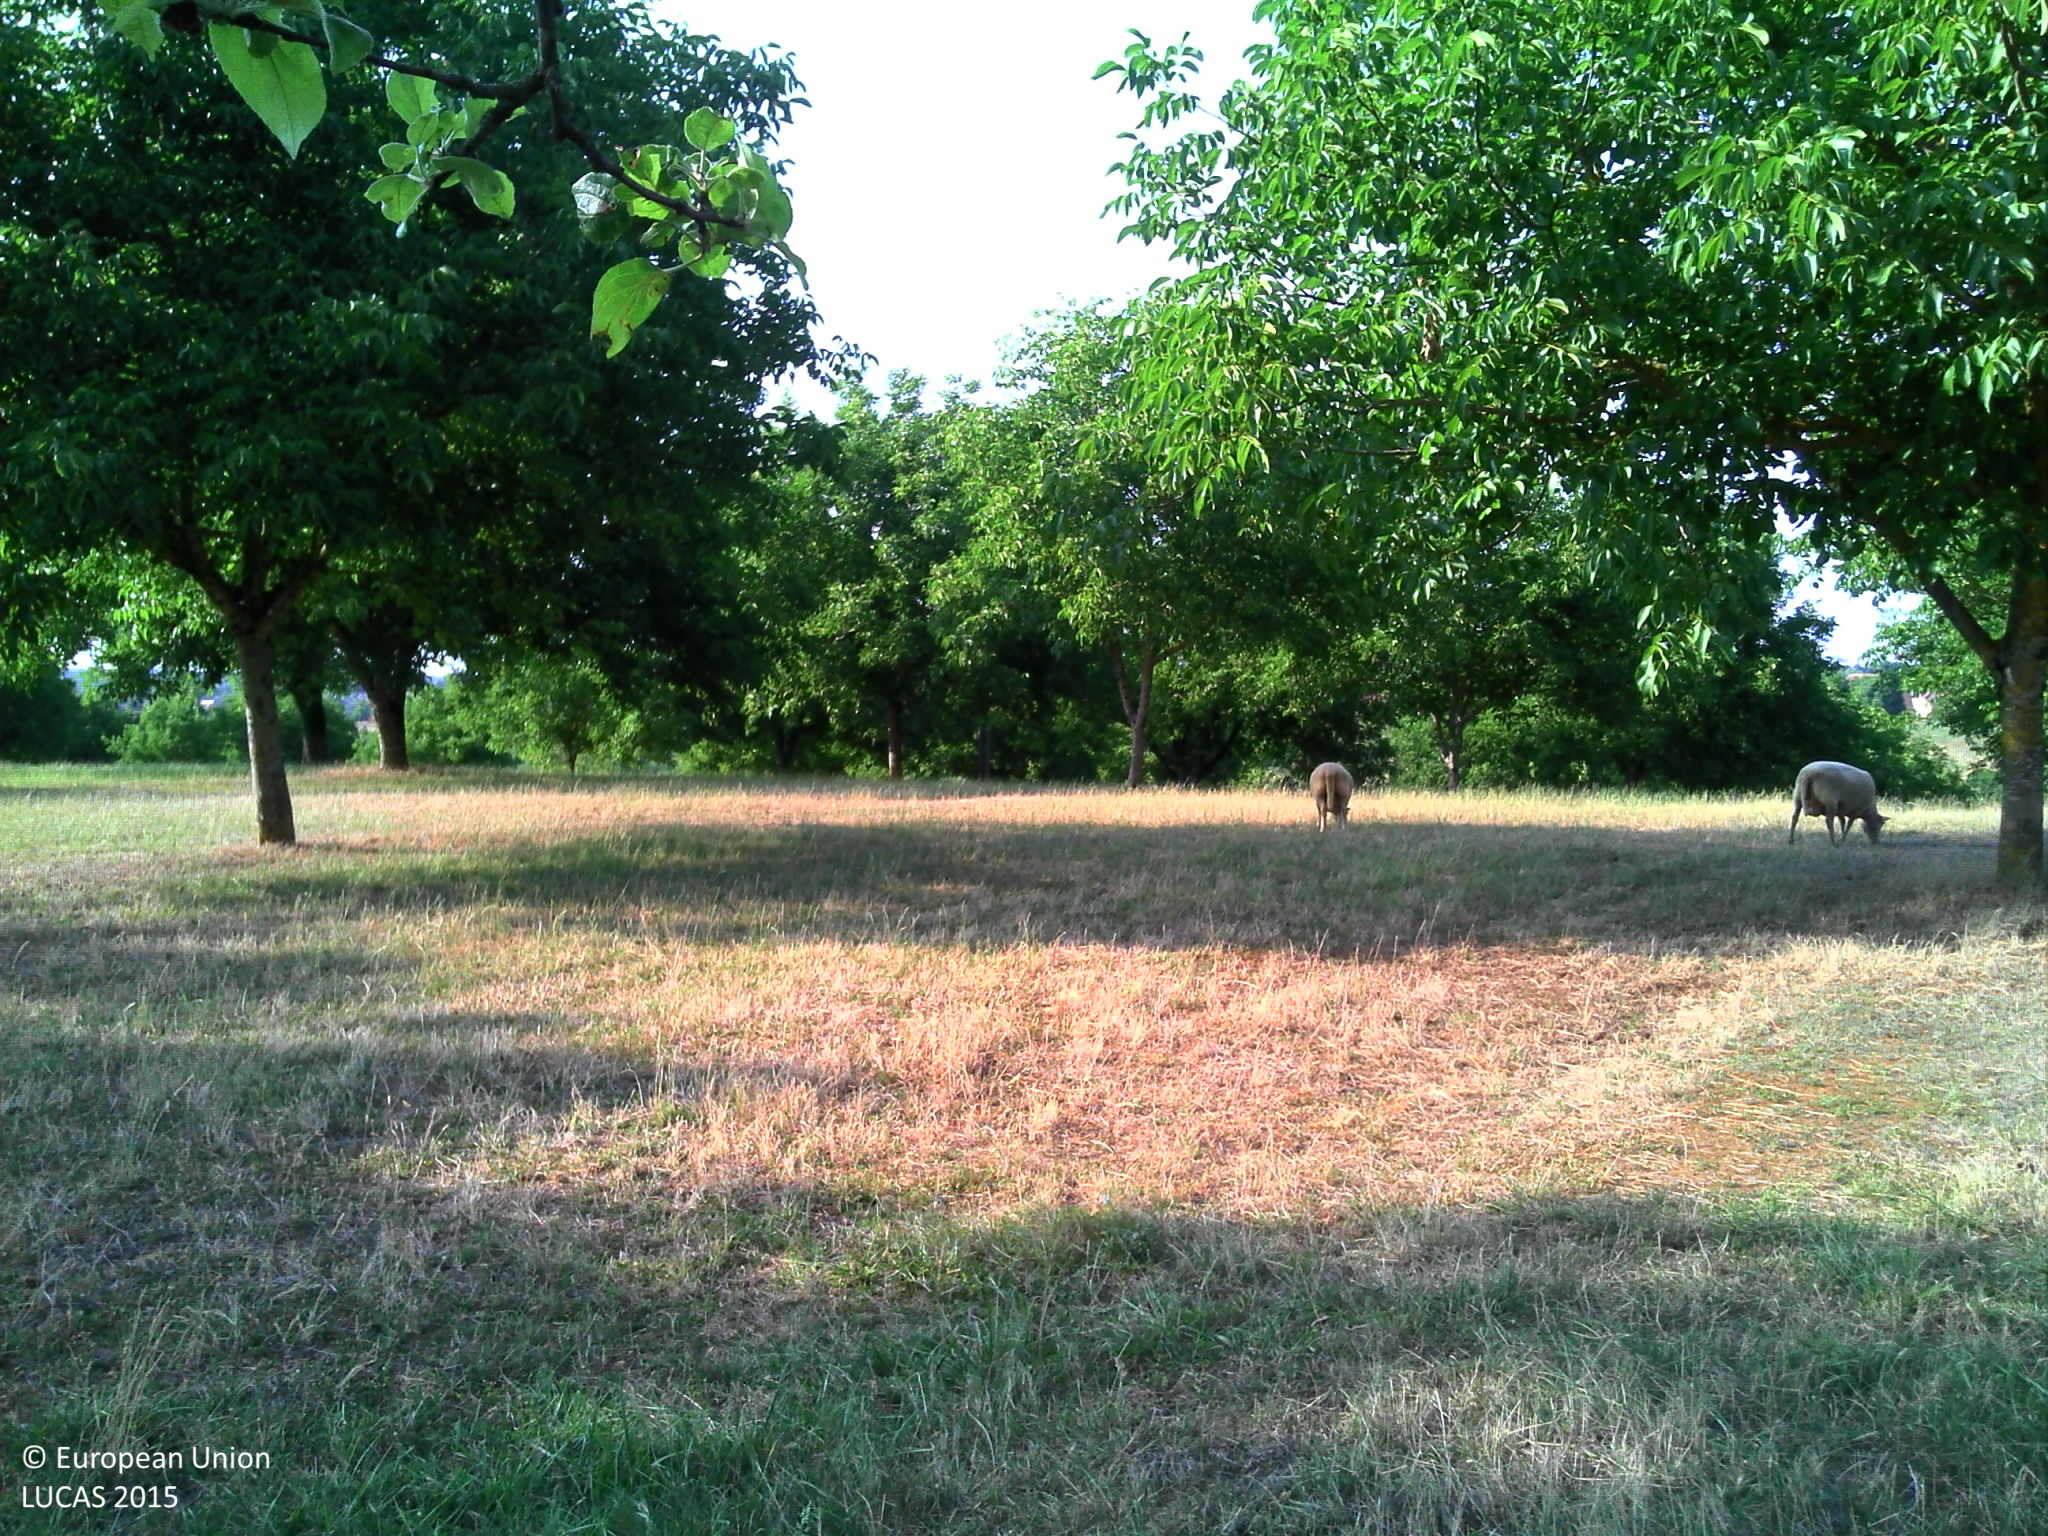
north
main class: Cropland
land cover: Apple fruit
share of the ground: 25 - 50 %
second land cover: Grassland without tree/shrub cover
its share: 50 - 75 %
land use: Agriculture (excluding fallow land and kitchen gardens)
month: July
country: FR
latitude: 45.3272
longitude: 1.0992
